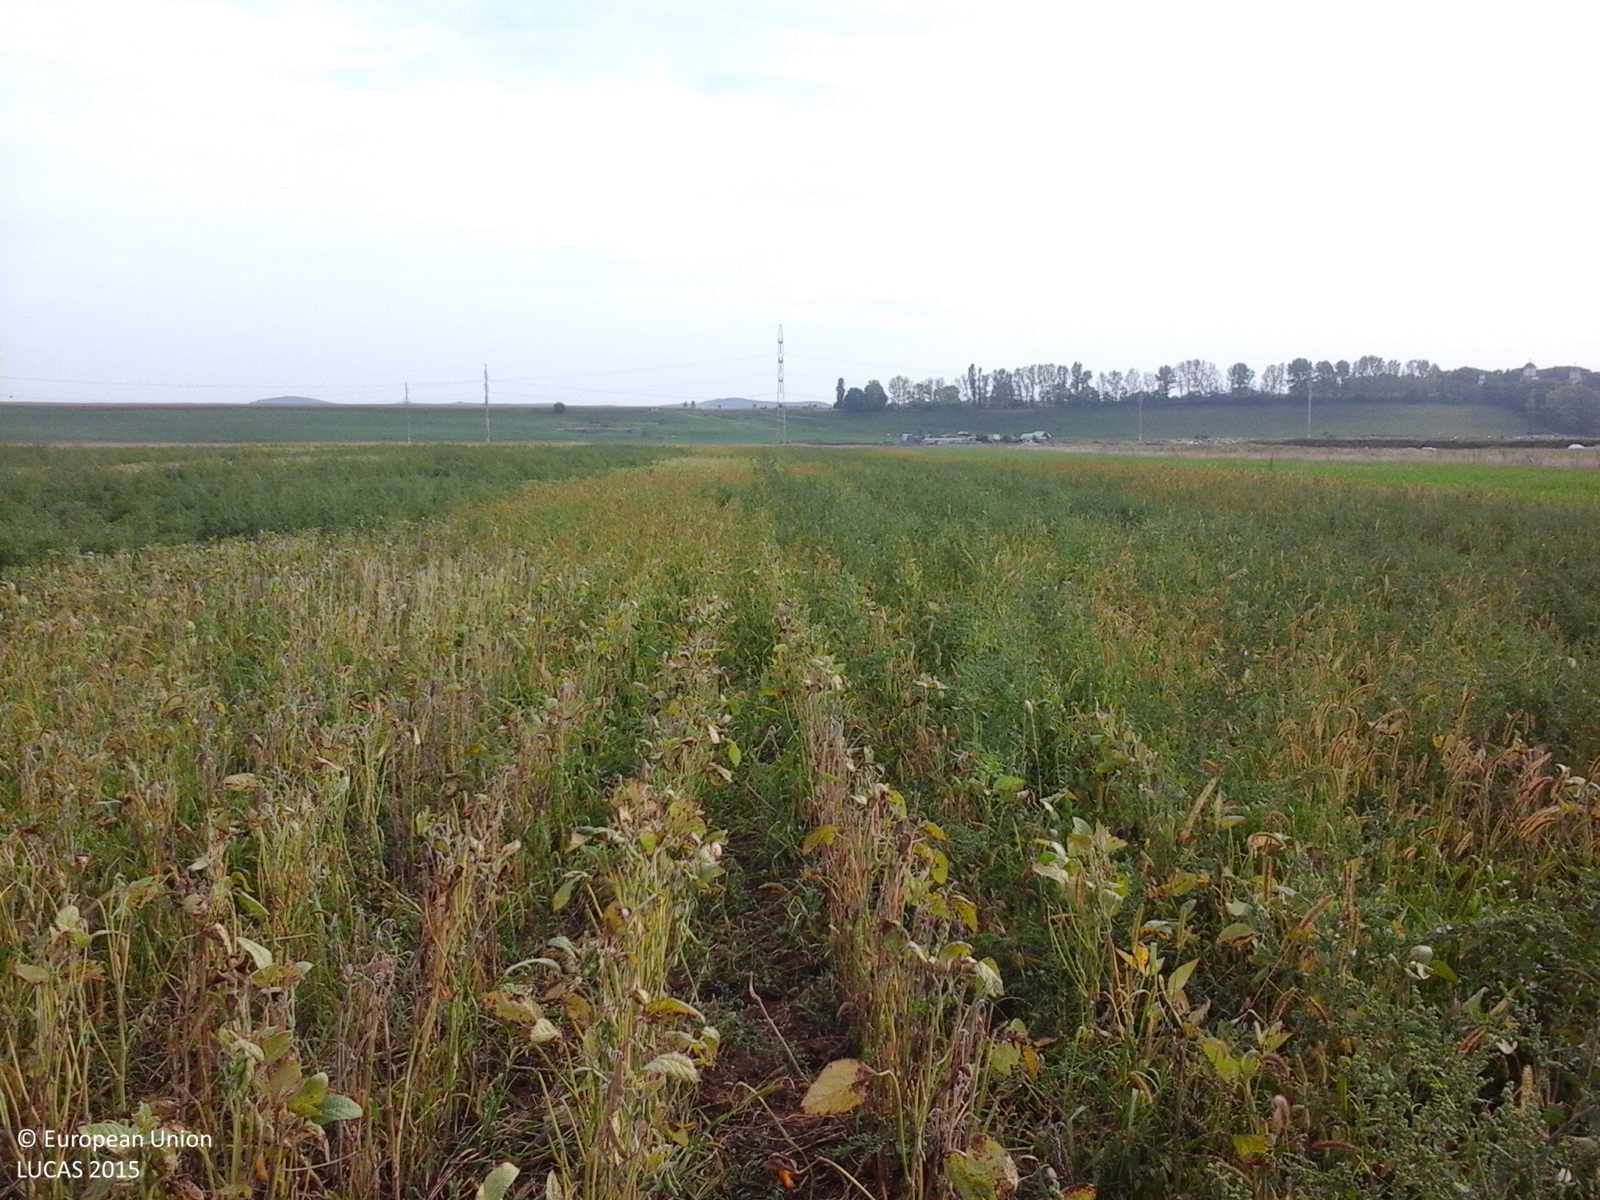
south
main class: Cropland
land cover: Soya
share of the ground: > 75 %
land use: Agriculture (excluding fallow land and kitchen gardens)
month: September
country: RO
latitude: 46.5464
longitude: 23.8061
